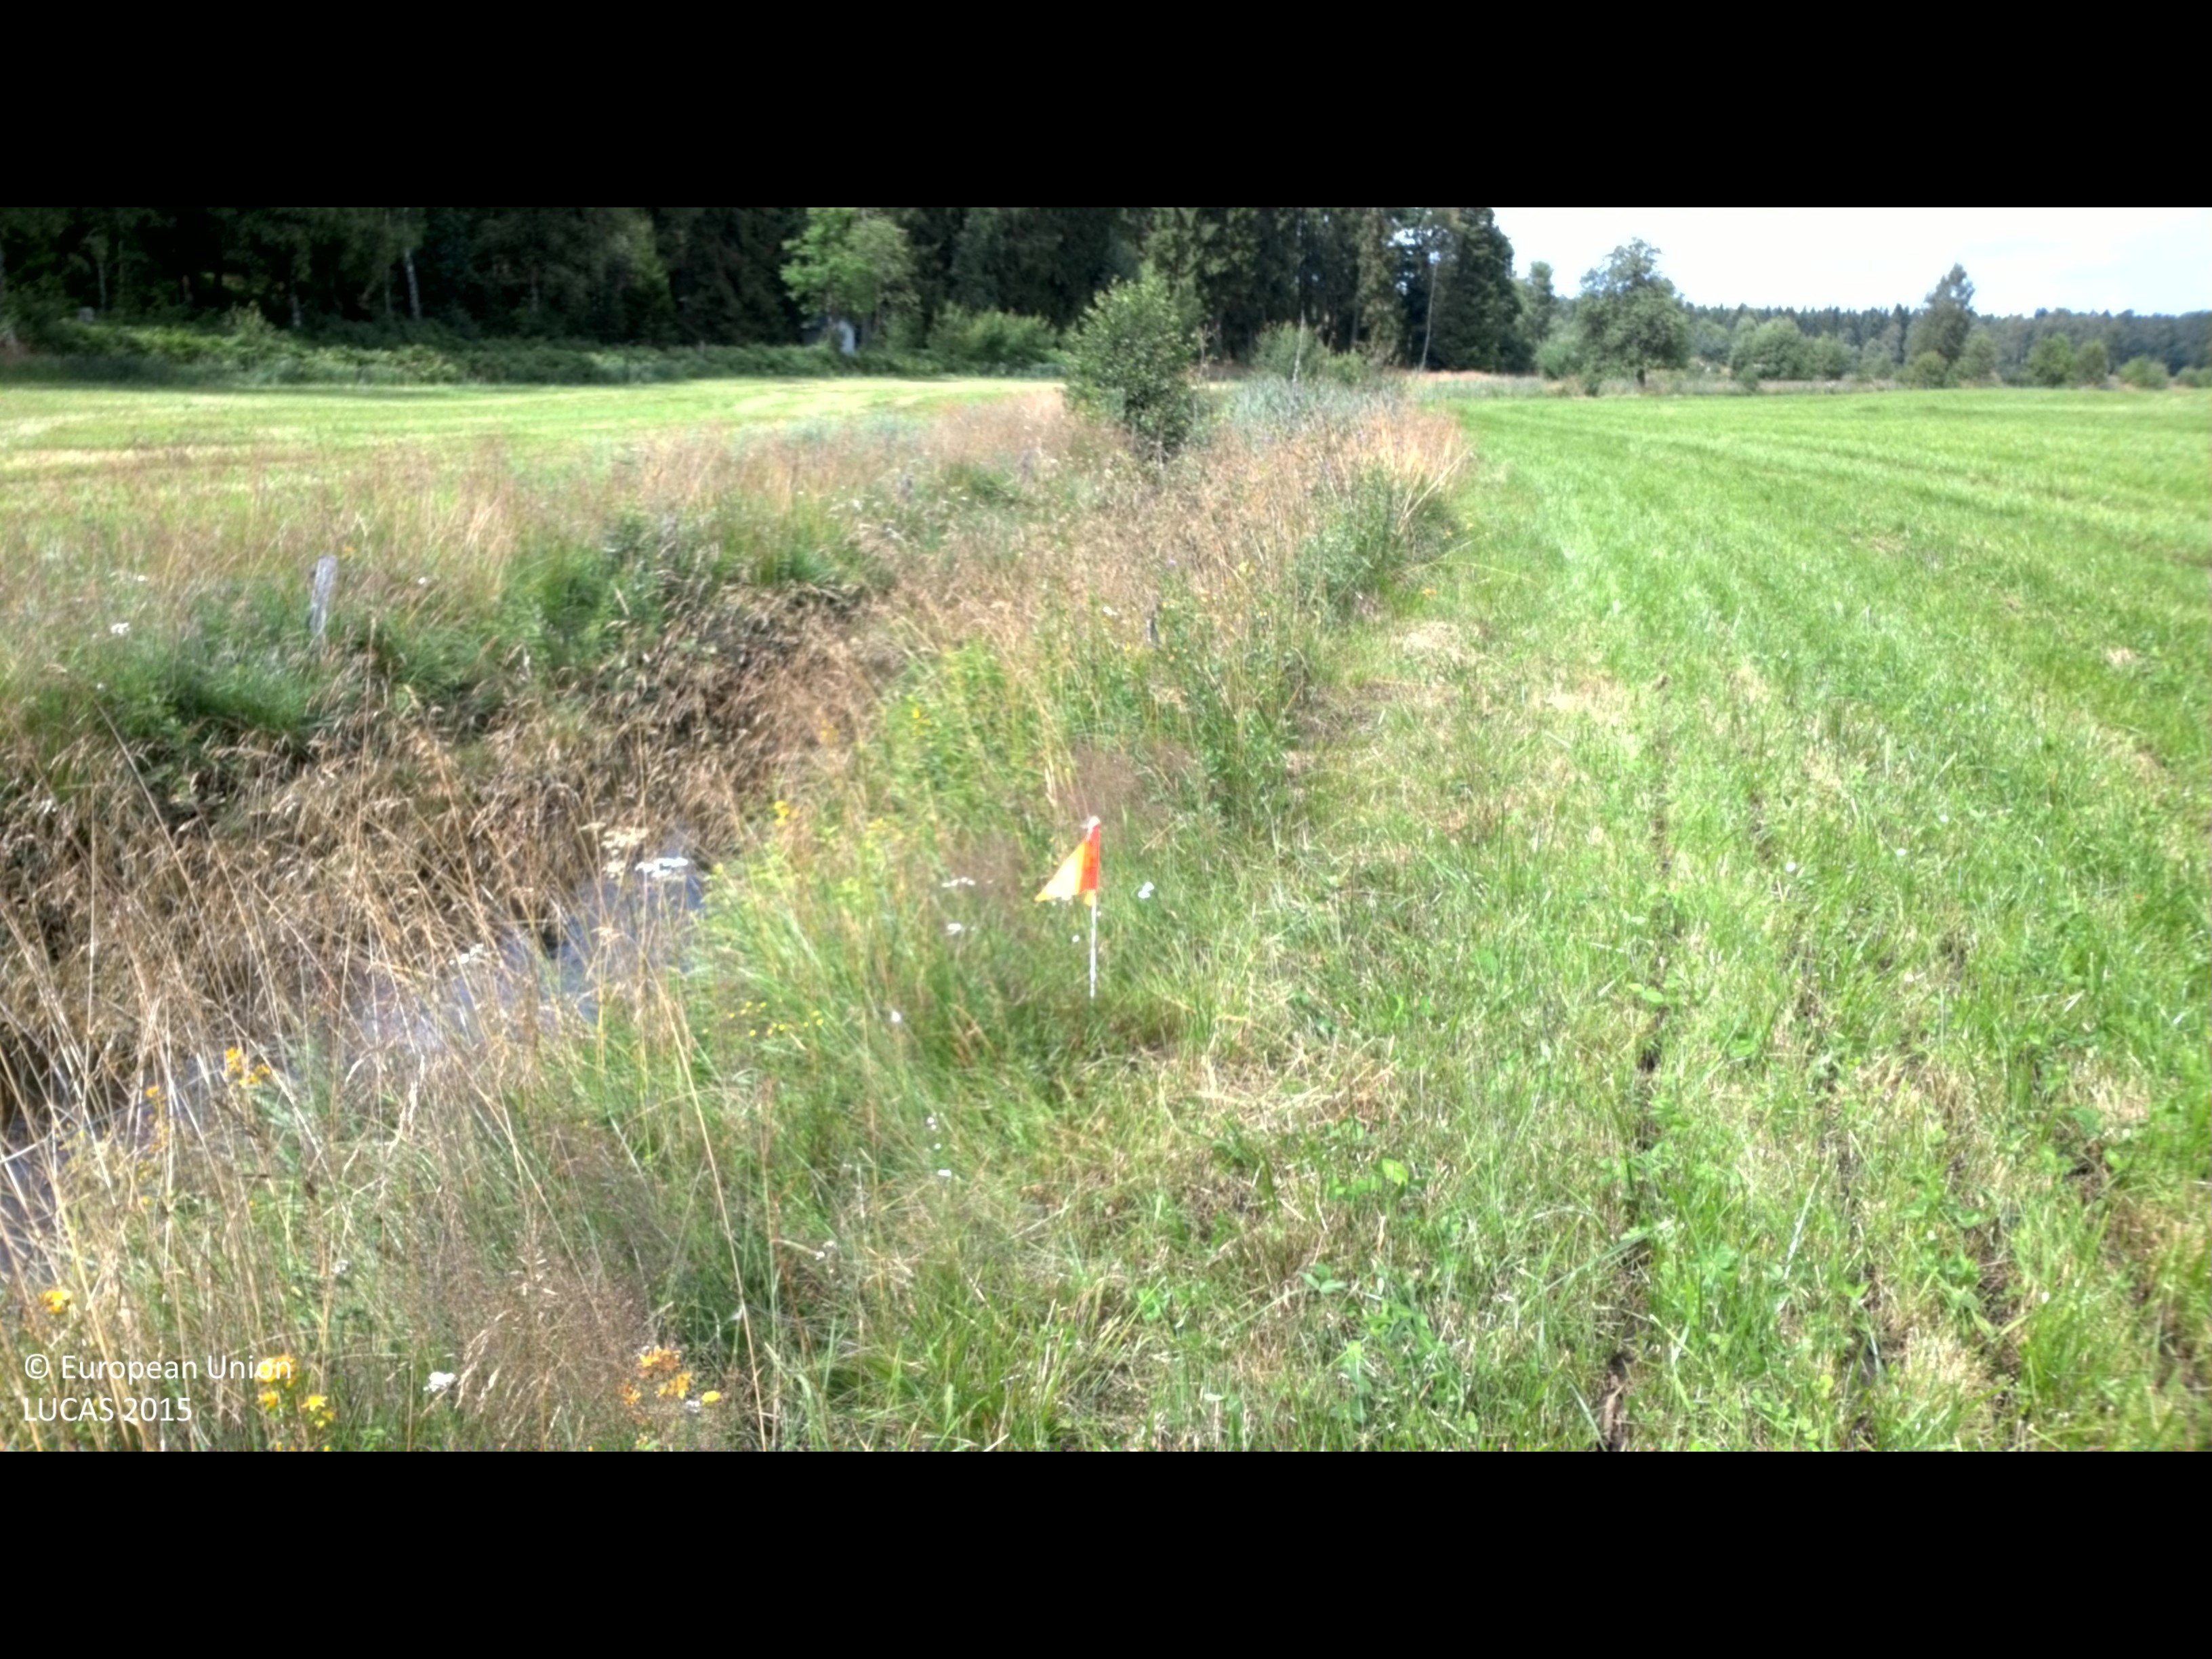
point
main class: Cropland
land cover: Temporary grasslands
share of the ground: > 75 %
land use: Agriculture (excluding fallow land and kitchen gardens)
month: August
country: SE
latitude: 56.3862
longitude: 14.2896
